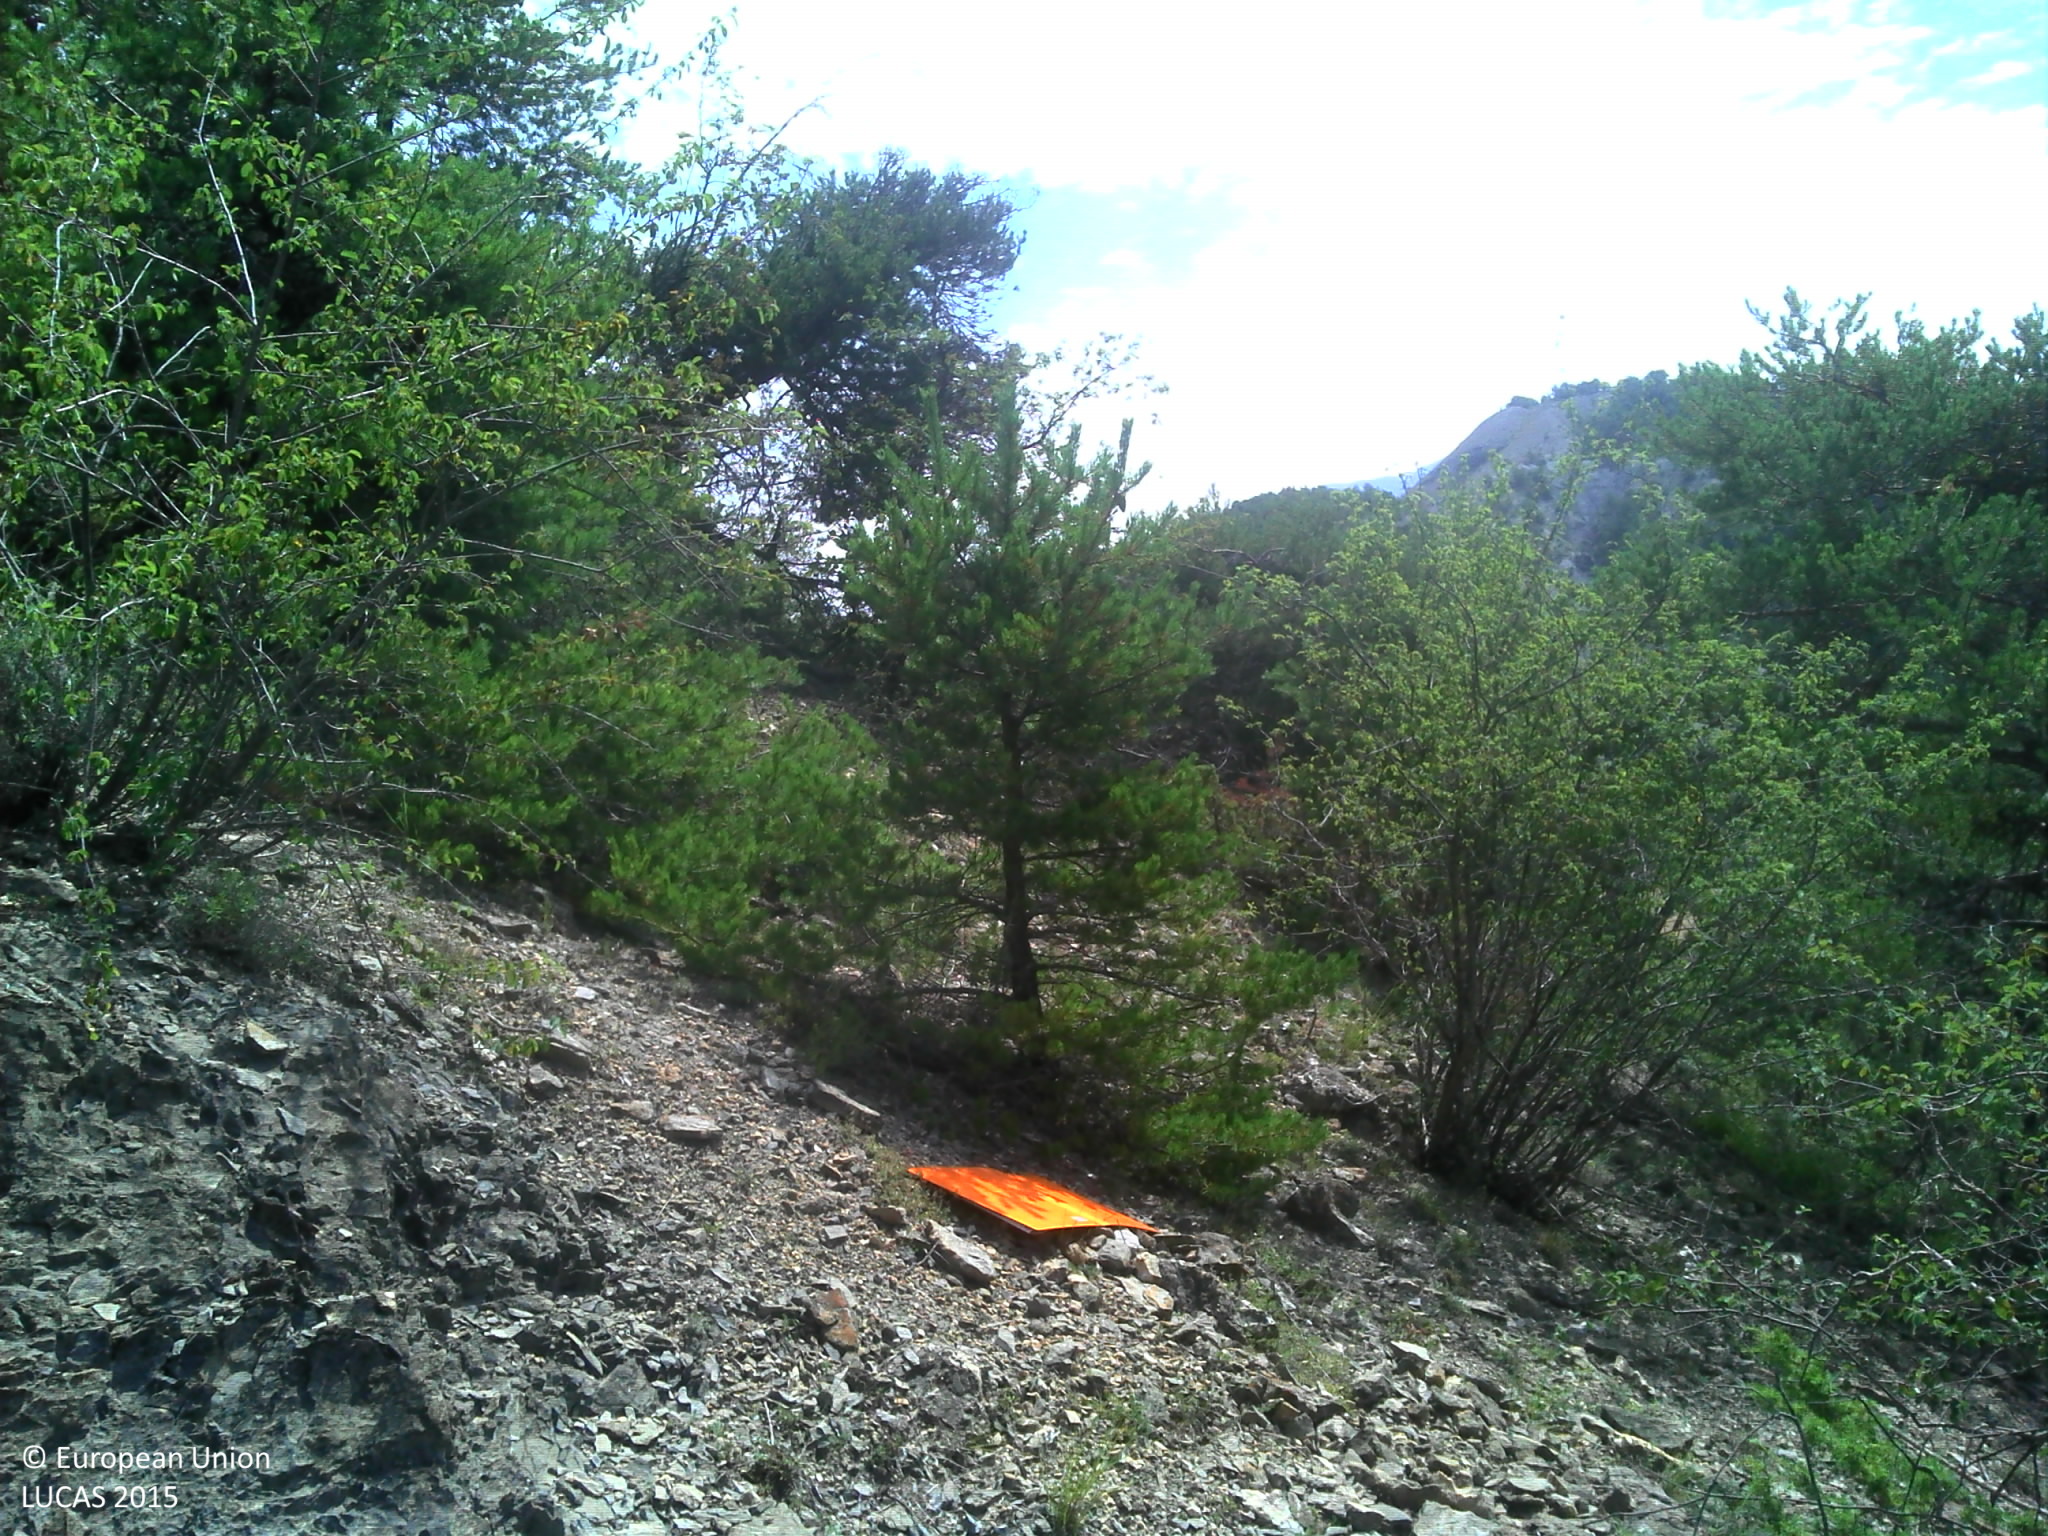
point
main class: Shrubland
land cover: Shrubland with sparse tree cover
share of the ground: 50 - 75 %
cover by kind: shrubs 50 %, unconsolidated bare surface 25 %, herbaceous plants 20 %, coniferous forest trees 5 %
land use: Semi-natural and natural areas not in use
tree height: < 5 m
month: July
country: FR
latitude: 44.4651
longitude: 6.2987
